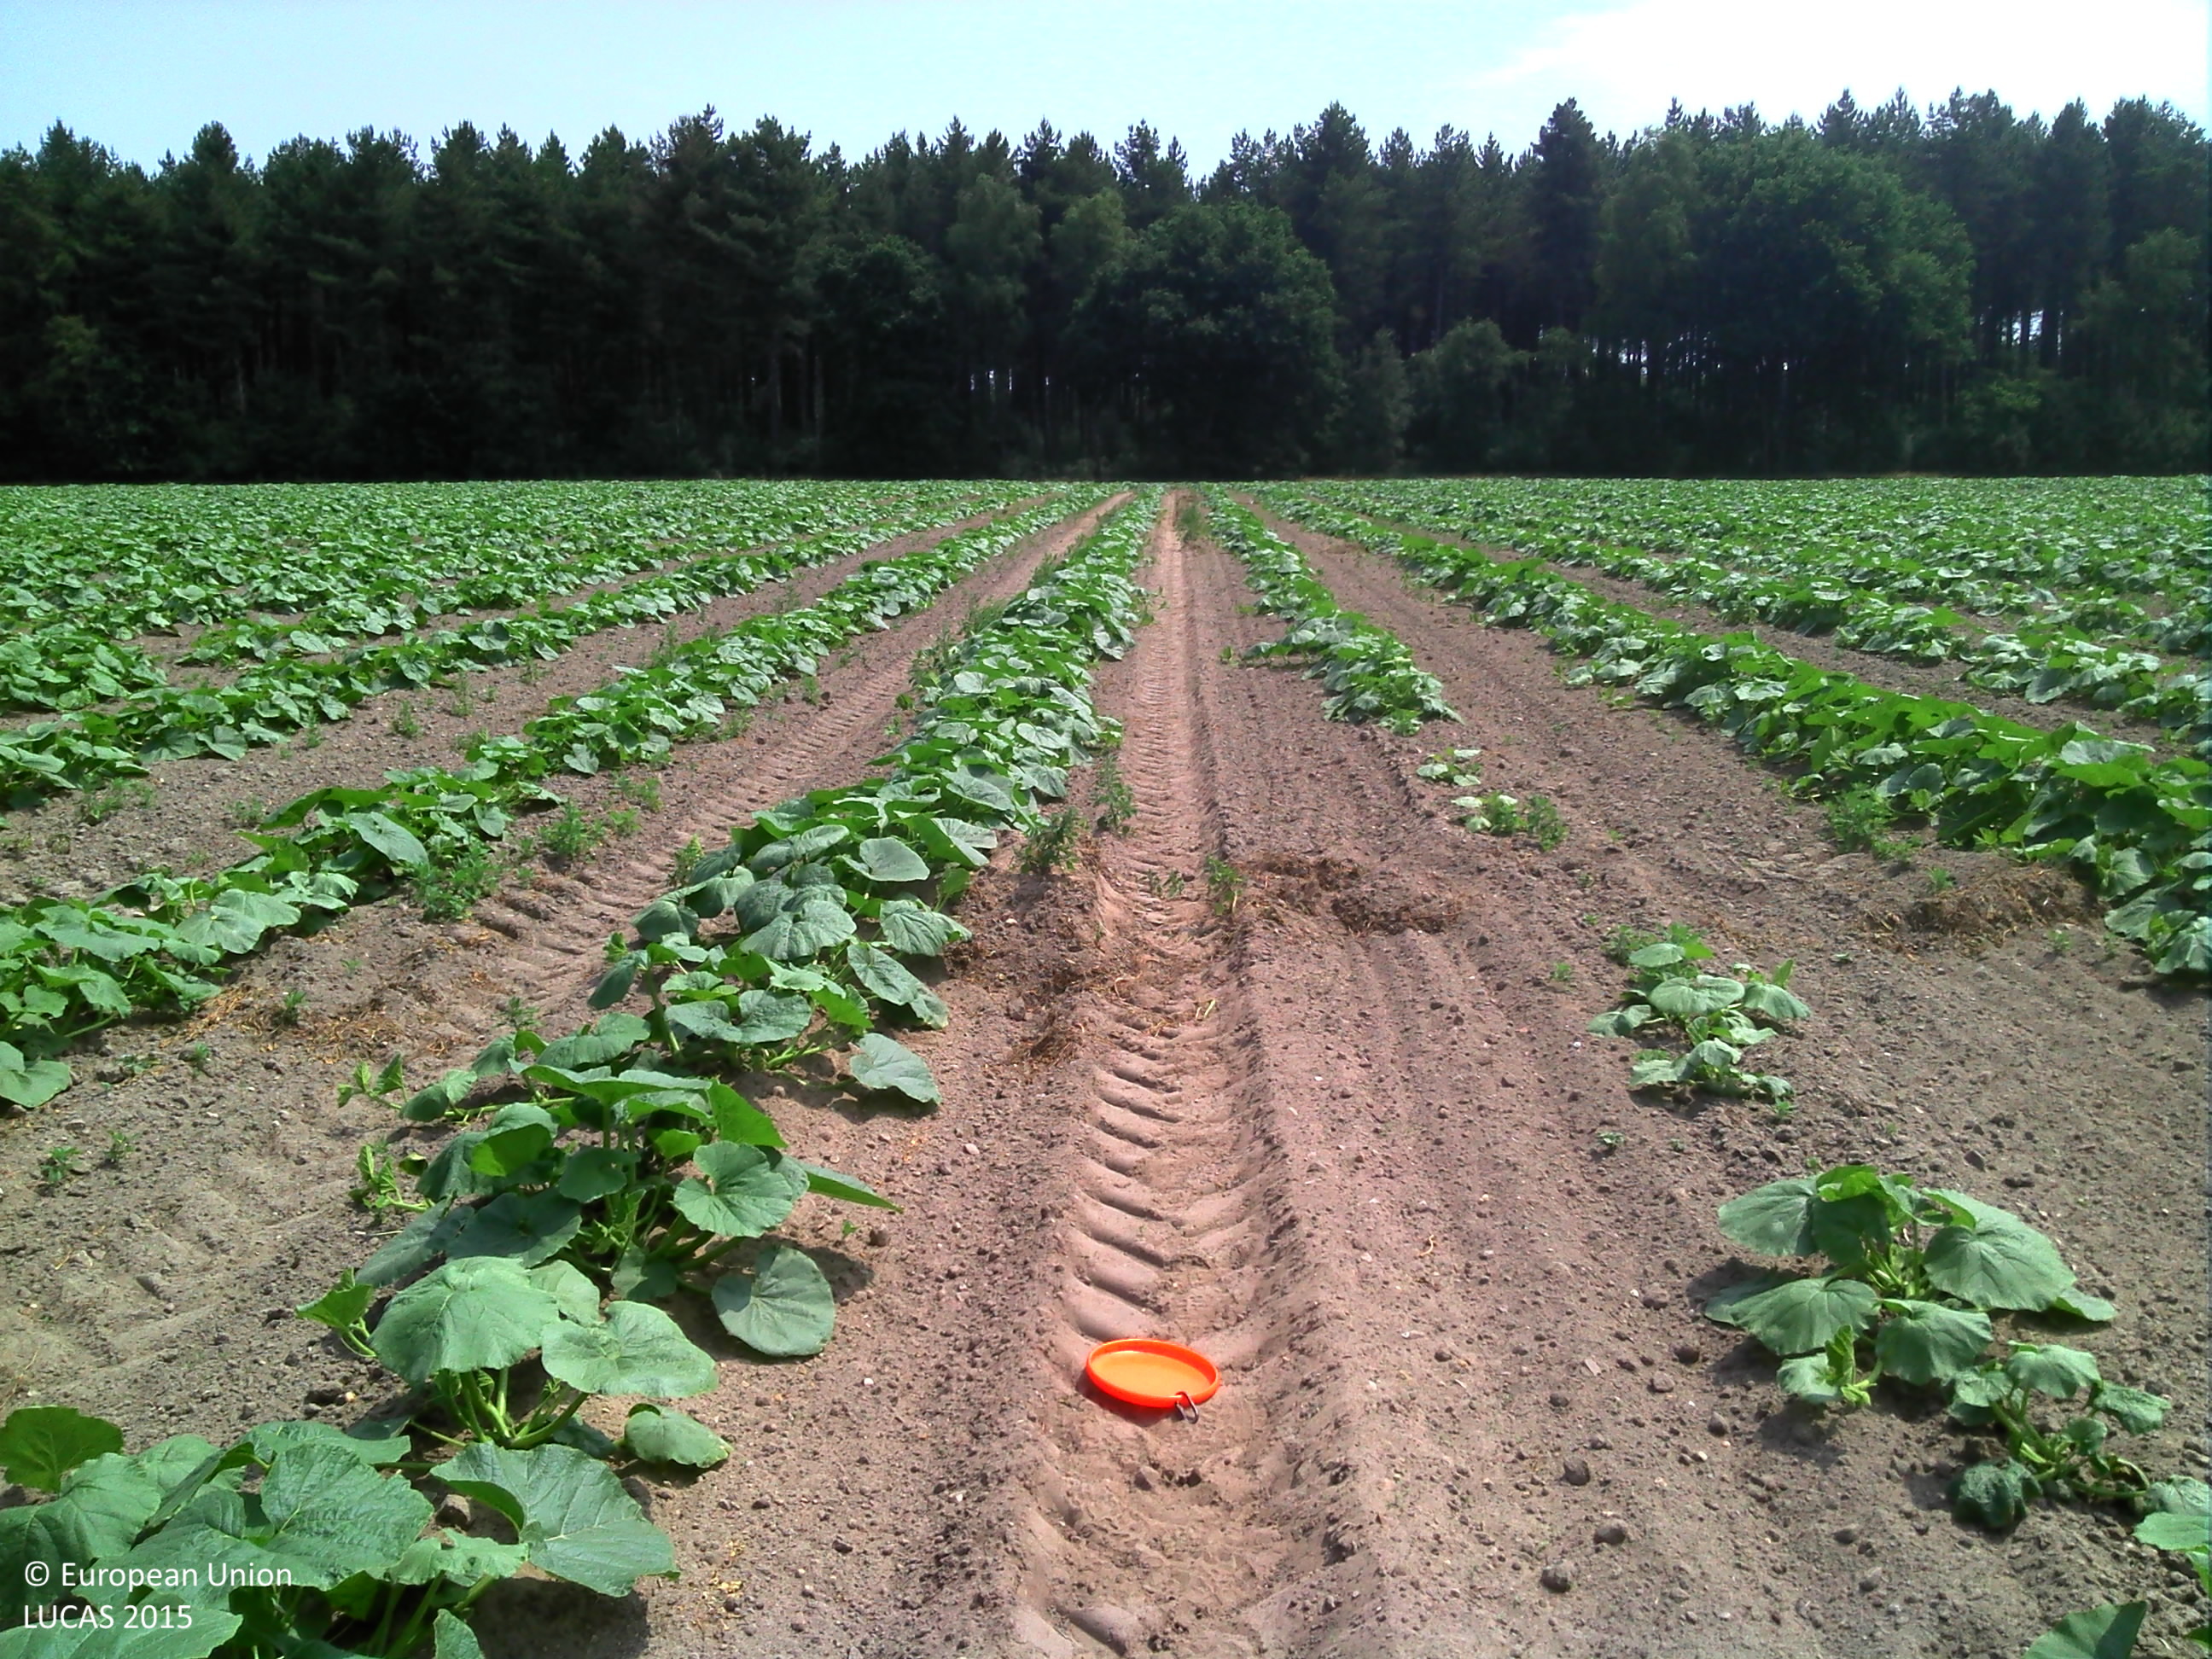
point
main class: Cropland
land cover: Other fresh vegetables
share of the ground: 10 - 25 %
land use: Agriculture (excluding fallow land and kitchen gardens)
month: July
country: BE
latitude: 51.0512
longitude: 5.5331
